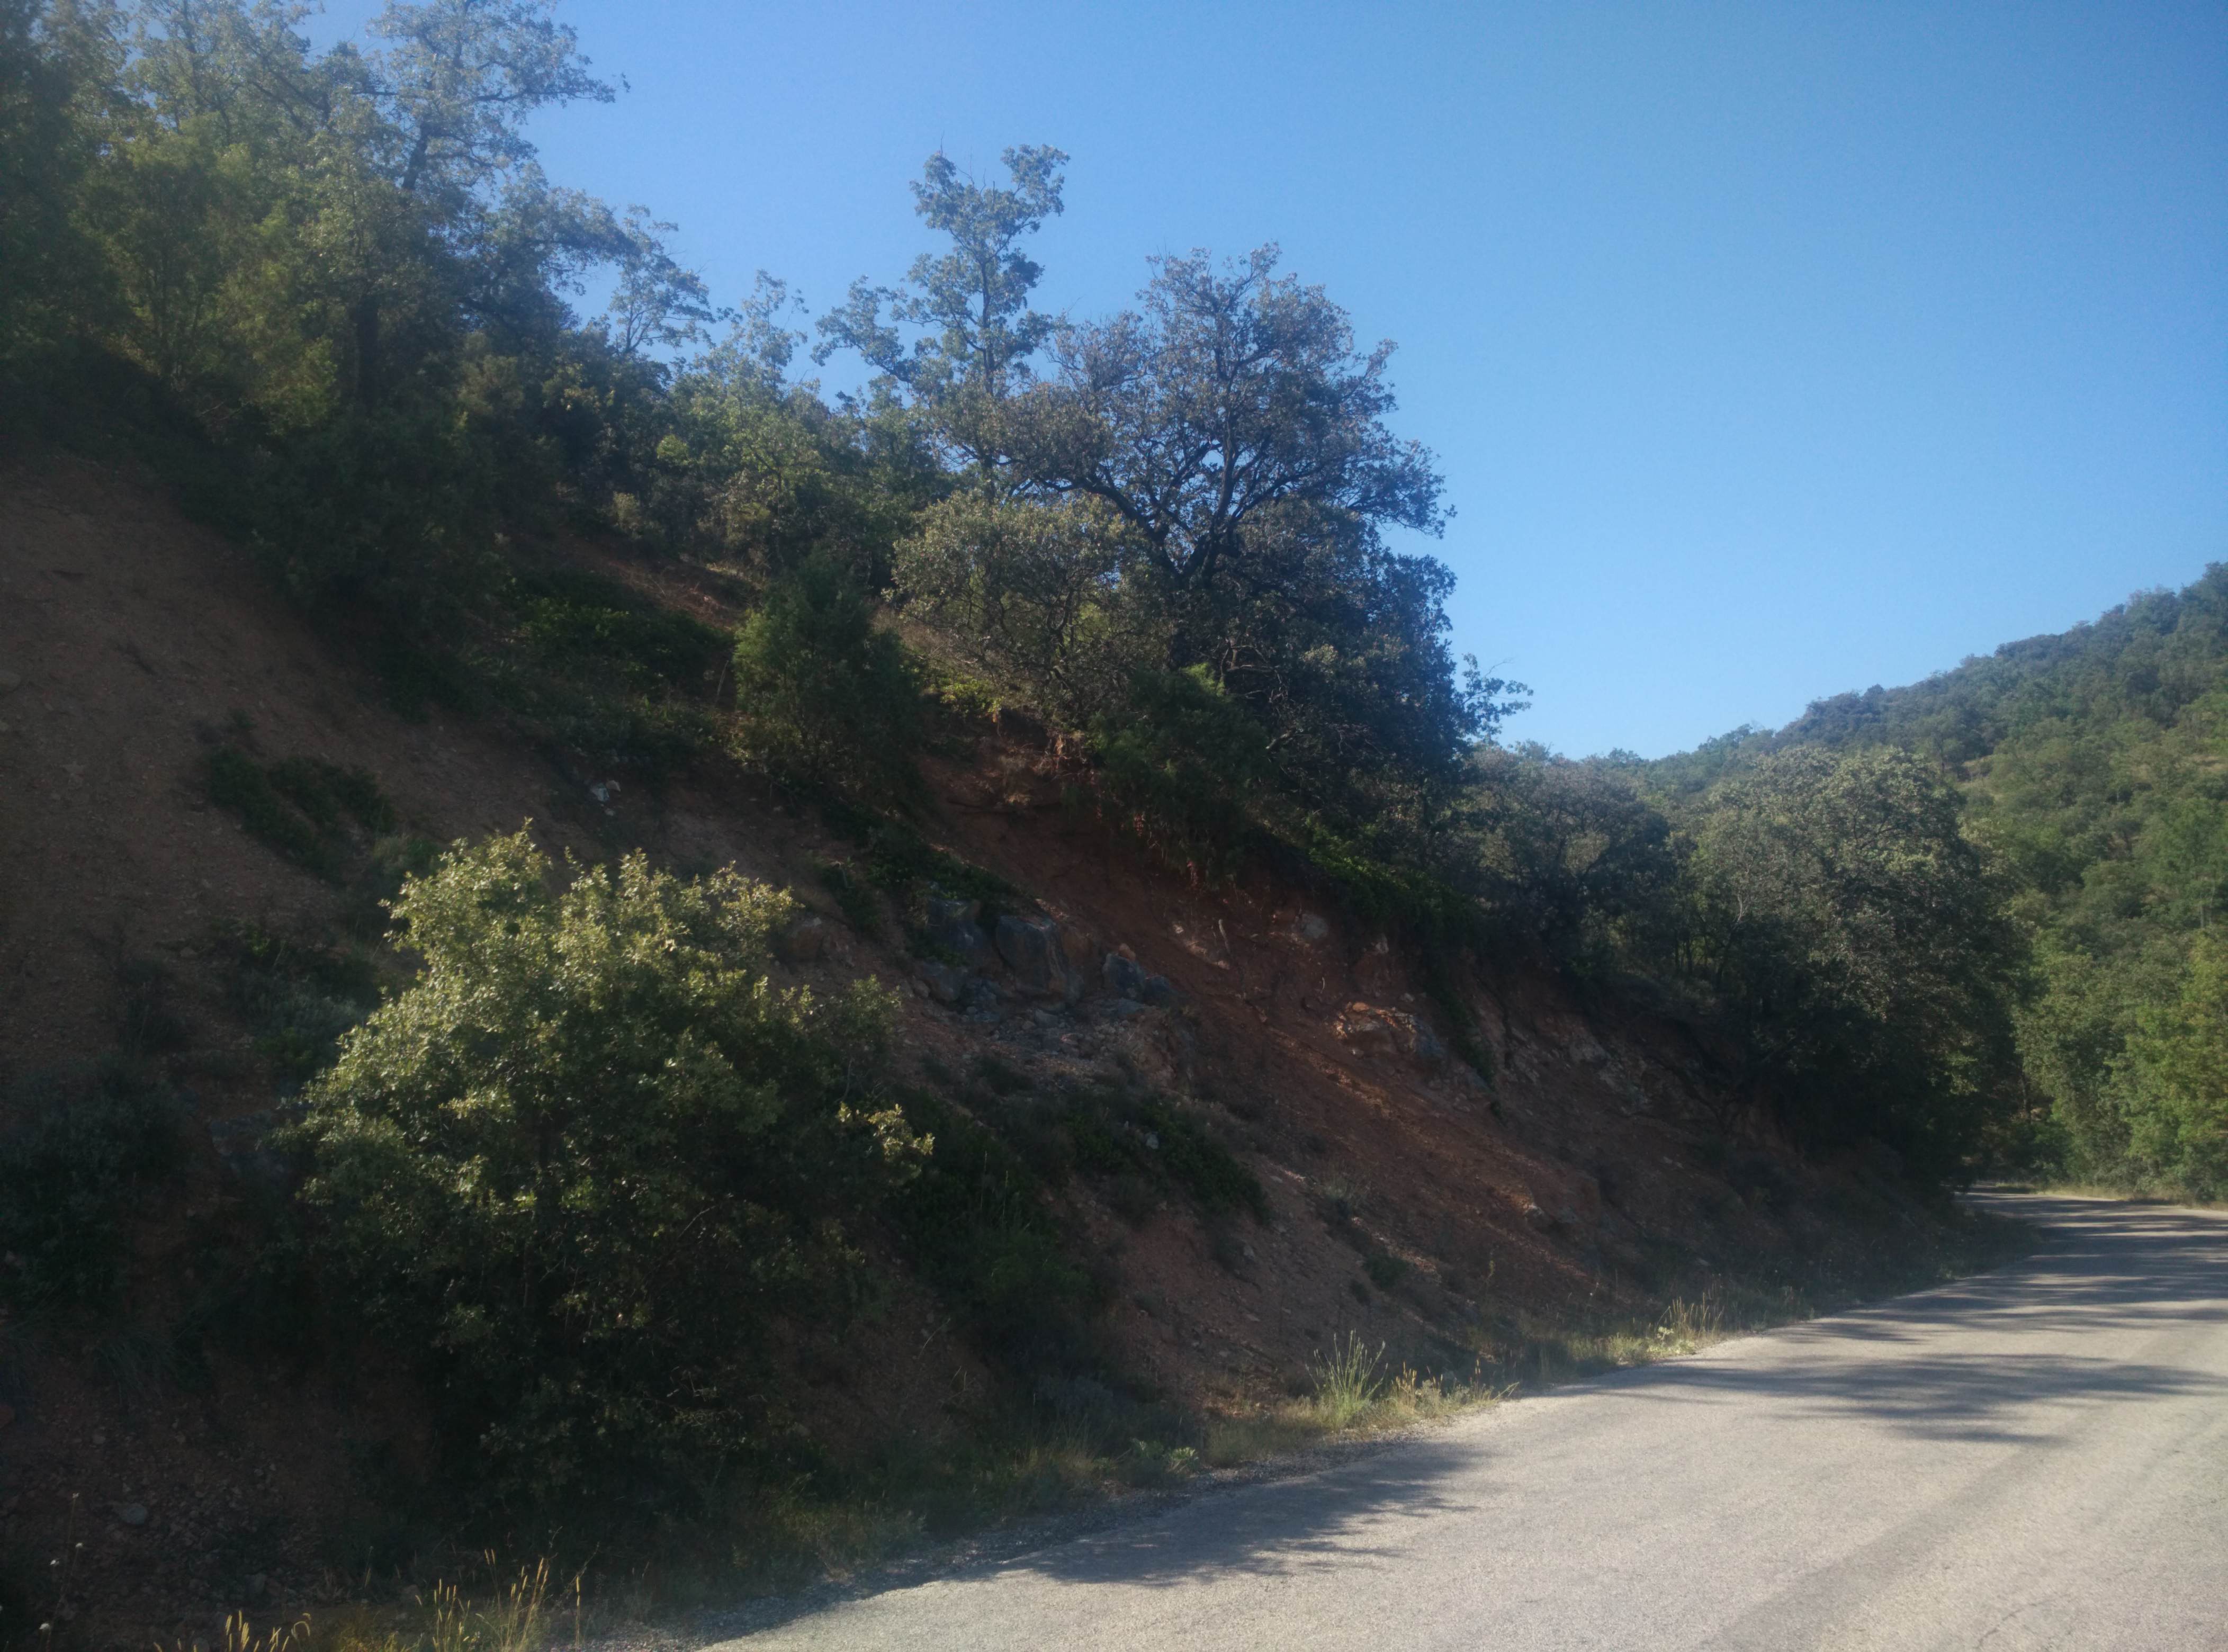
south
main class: Woodland
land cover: Broadleaved woodland
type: thermophilous deciduous forest
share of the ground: 50 - 75 %
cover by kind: broadleaved forest trees 60 %, unconsolidated bare surface 30 %, shrubs 10 %
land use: Semi-natural and natural areas not in use
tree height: > 5 m
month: July
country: ES
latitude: 40.7169
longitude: -2.8512
